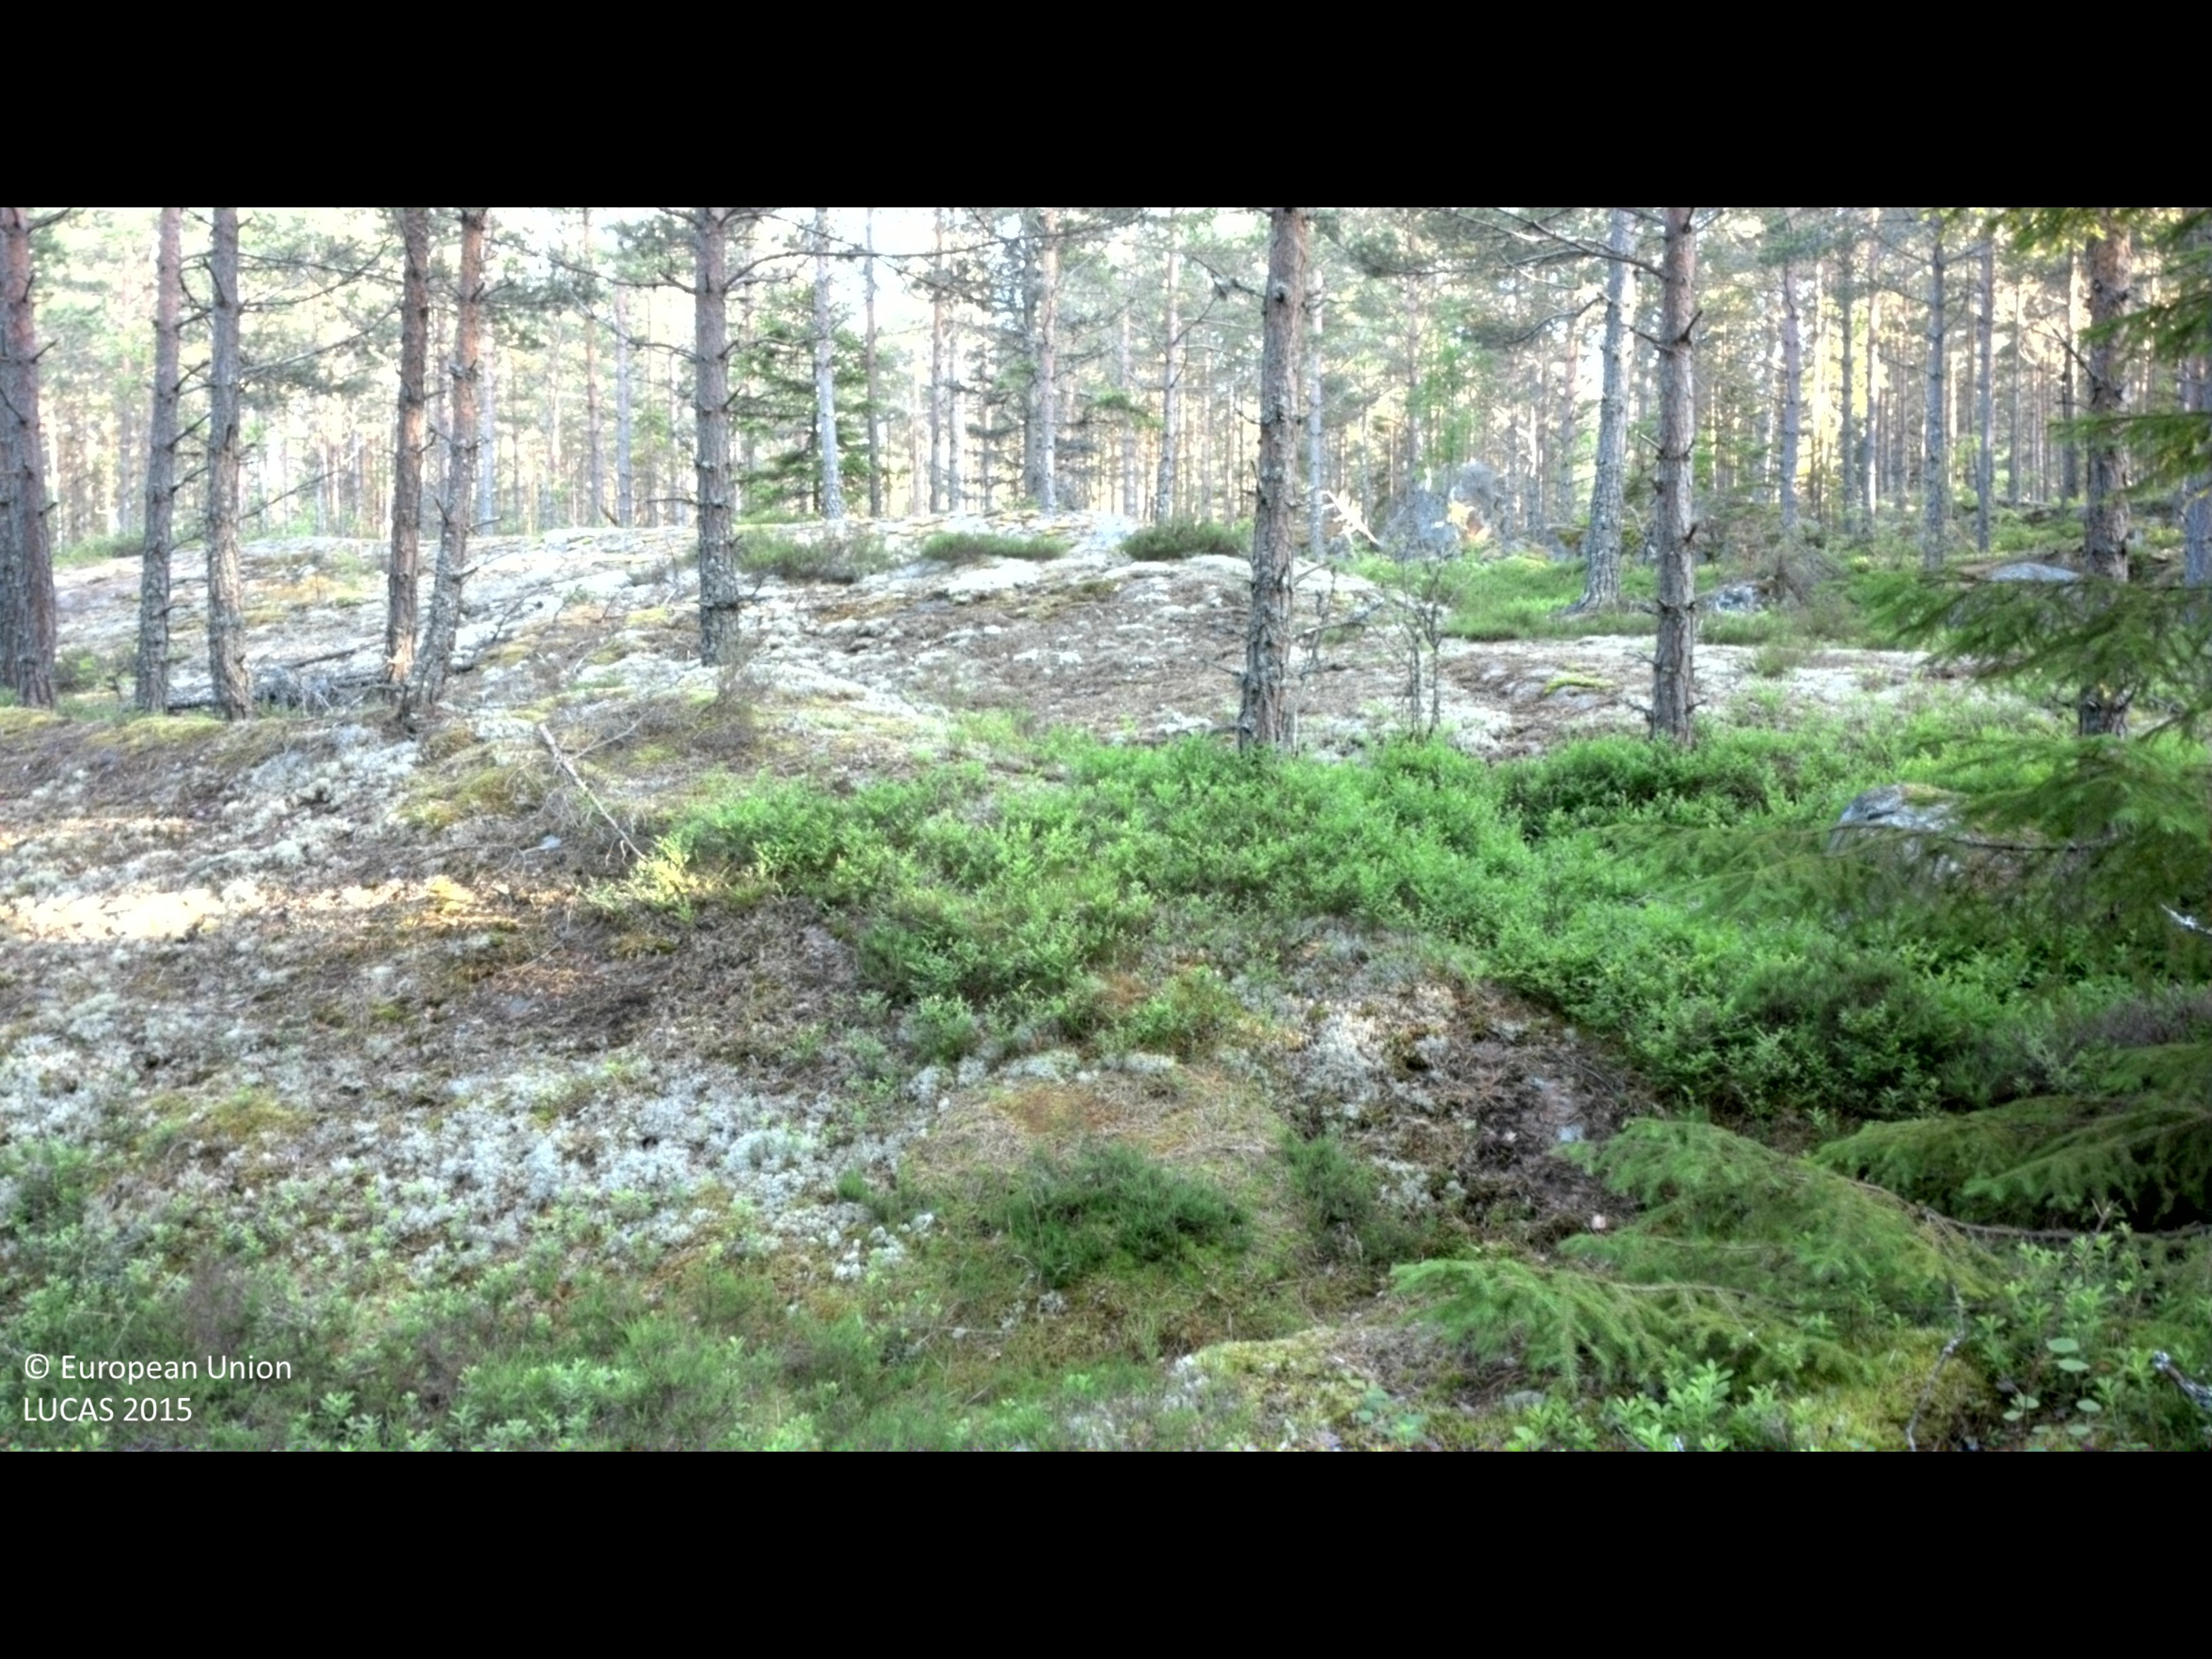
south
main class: Woodland
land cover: Pine dominated coniferous woodland
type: boreal forest
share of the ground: 50 - 75 %
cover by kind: coniferous forest trees 55 %, shrubs 30 %, lichens and mosses 15 %
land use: Forestry
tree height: > 5 m
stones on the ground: < 10 %
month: June
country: SE
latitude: 57.9829
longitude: 16.2712
